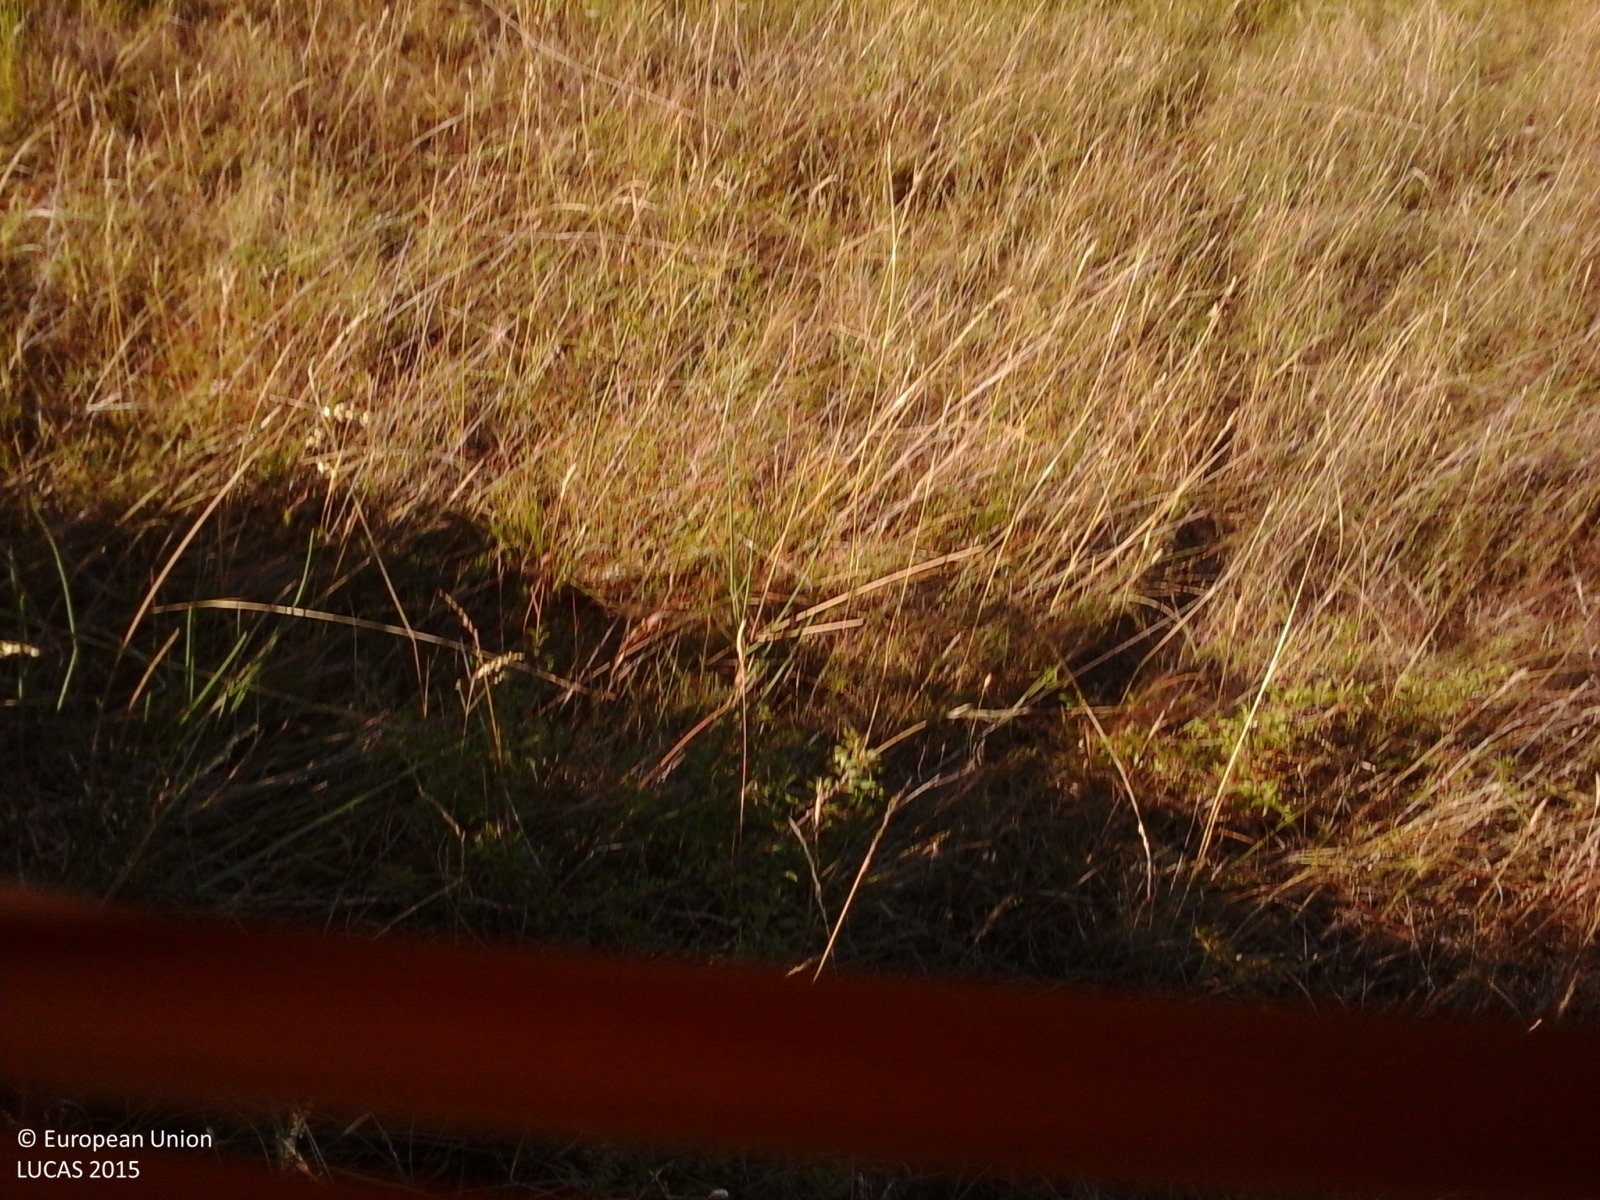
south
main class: Woodland
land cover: Broadleaved woodland
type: thermophilous deciduous forest
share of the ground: > 75 %
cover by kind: broadleaved forest trees 70 %, shrubs 20 %, herbaceous plants 10 %
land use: Semi-natural and natural areas not in use
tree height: < 5 m
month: August
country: IT
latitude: 42.9480
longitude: 11.6250
